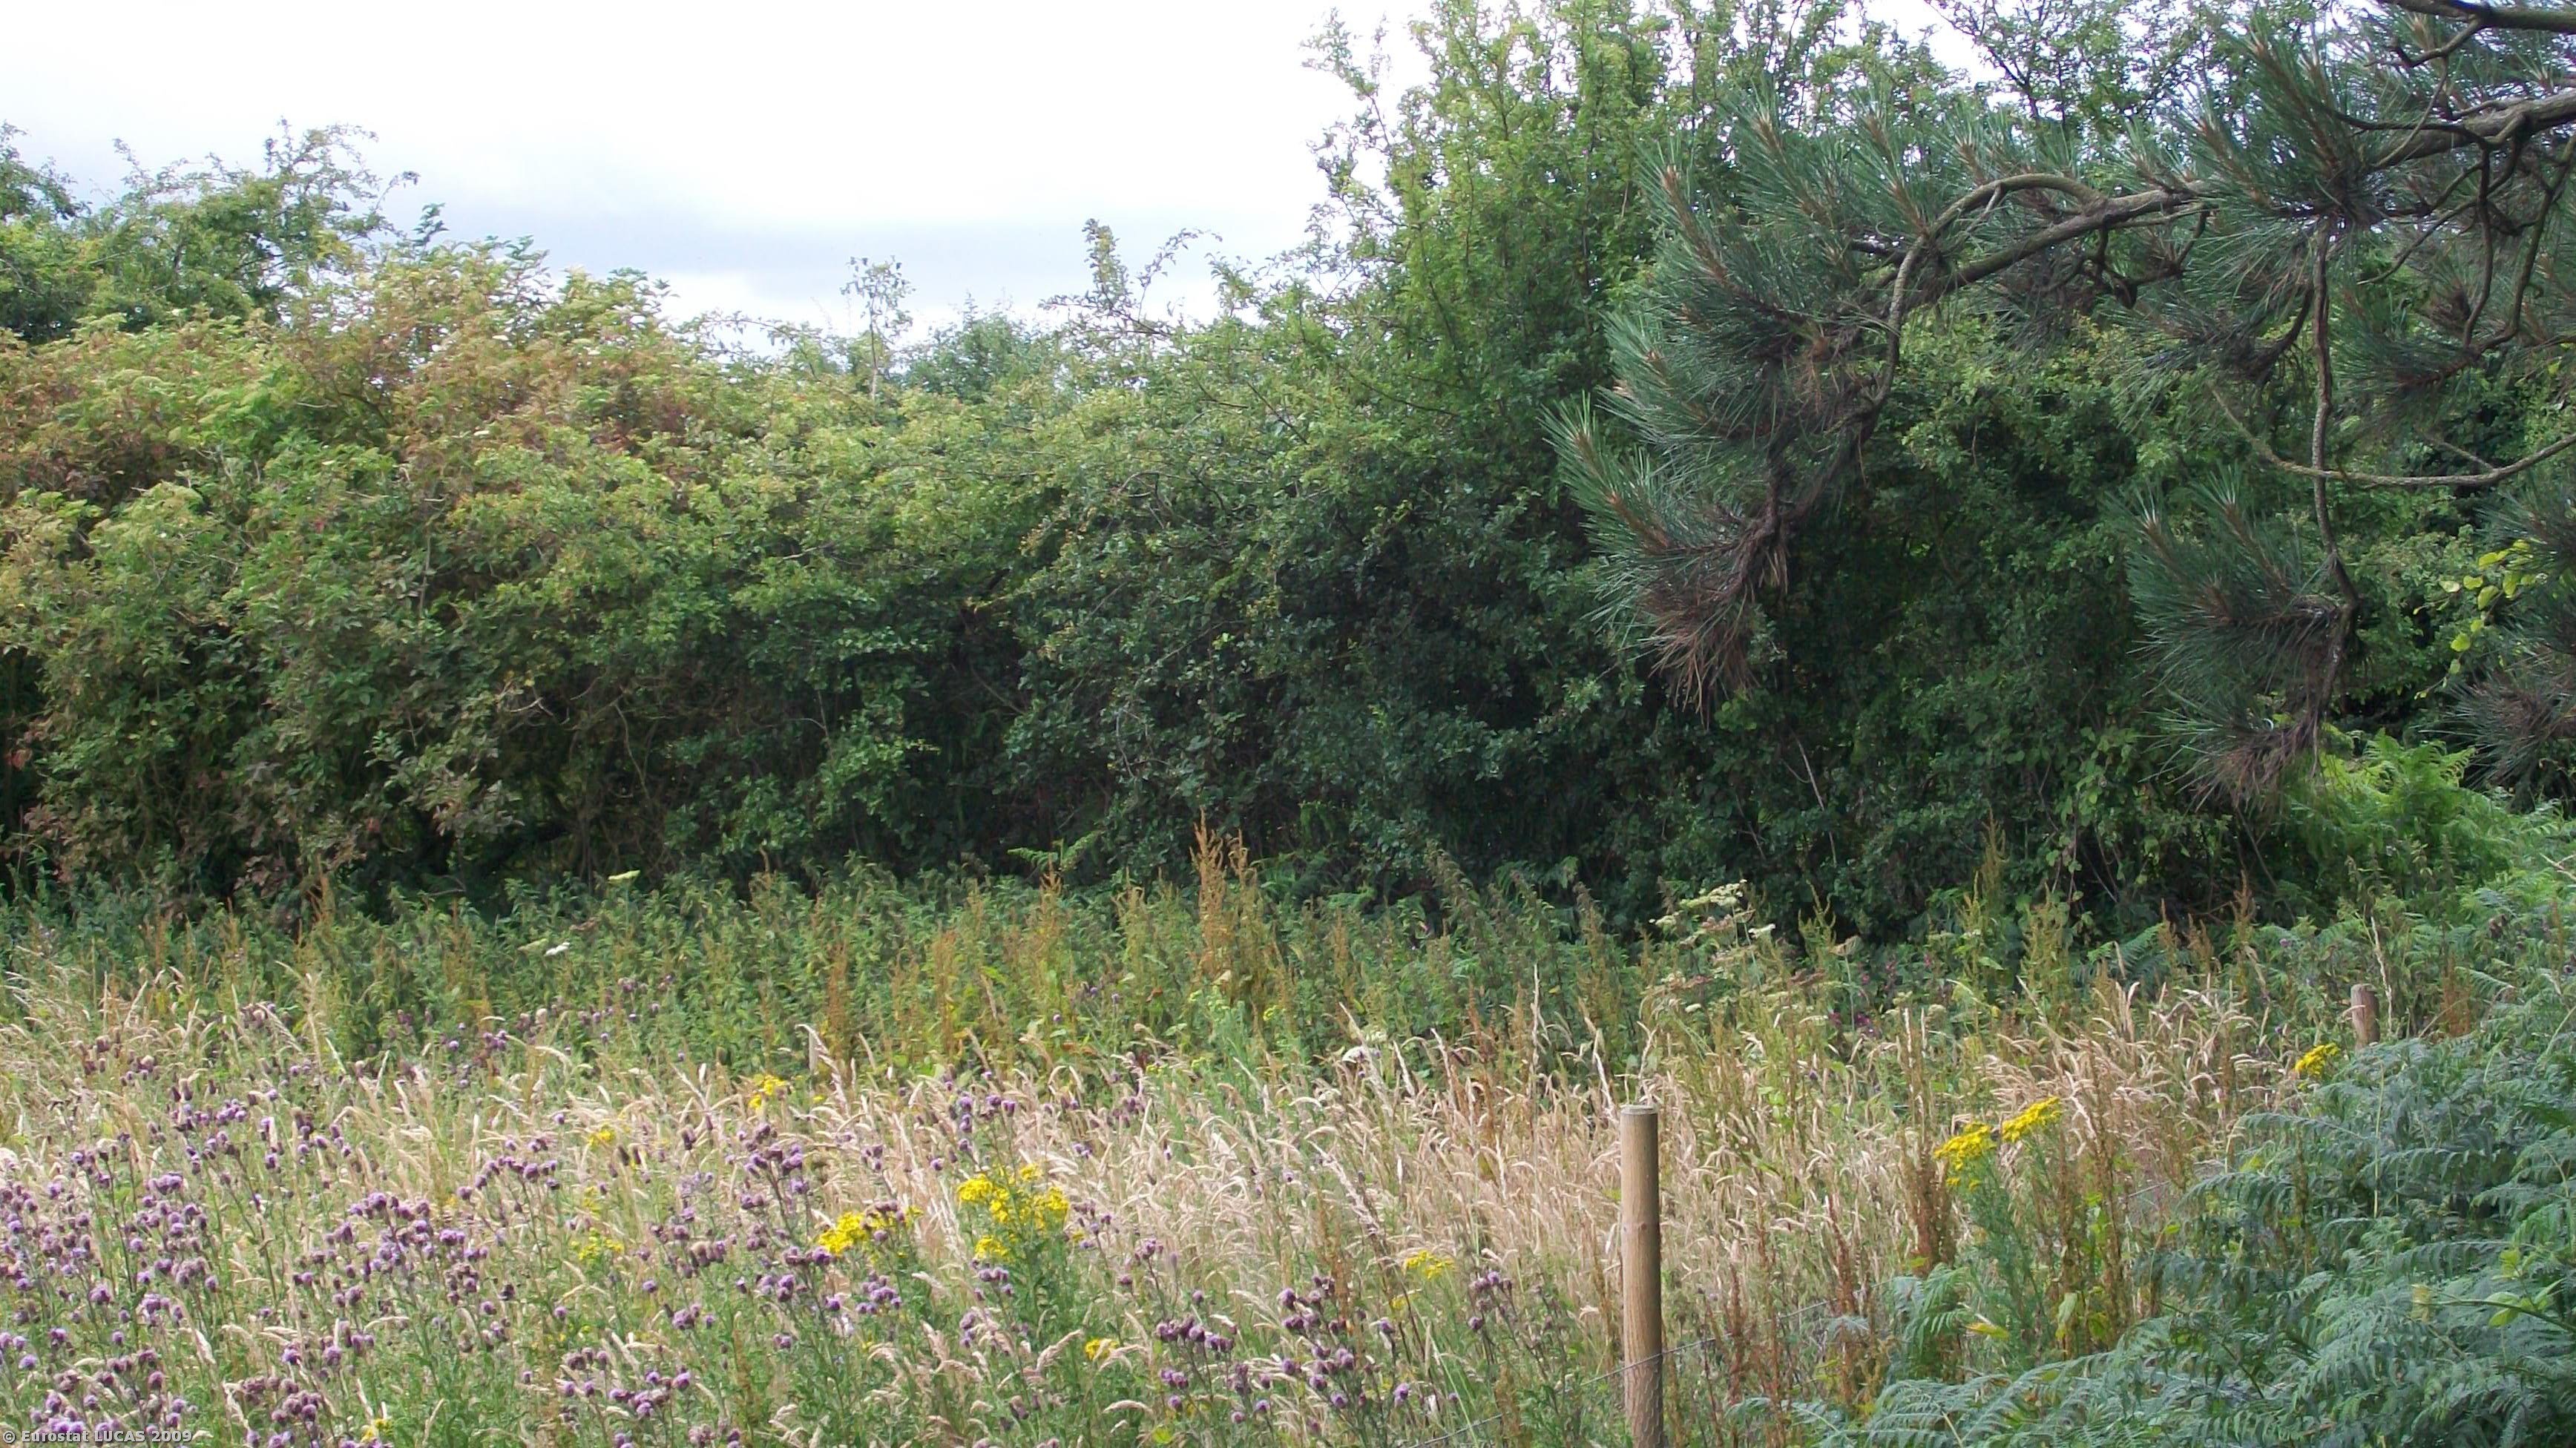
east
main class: Cropland
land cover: Common wheat
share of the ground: > 75 %
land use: Agriculture (excluding fallow land and kitchen gardens)
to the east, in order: Common wheat; Grass margins; Managed hedges; Grass margins; Common wheat
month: July
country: GB
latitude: 53.5458
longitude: -0.2515
